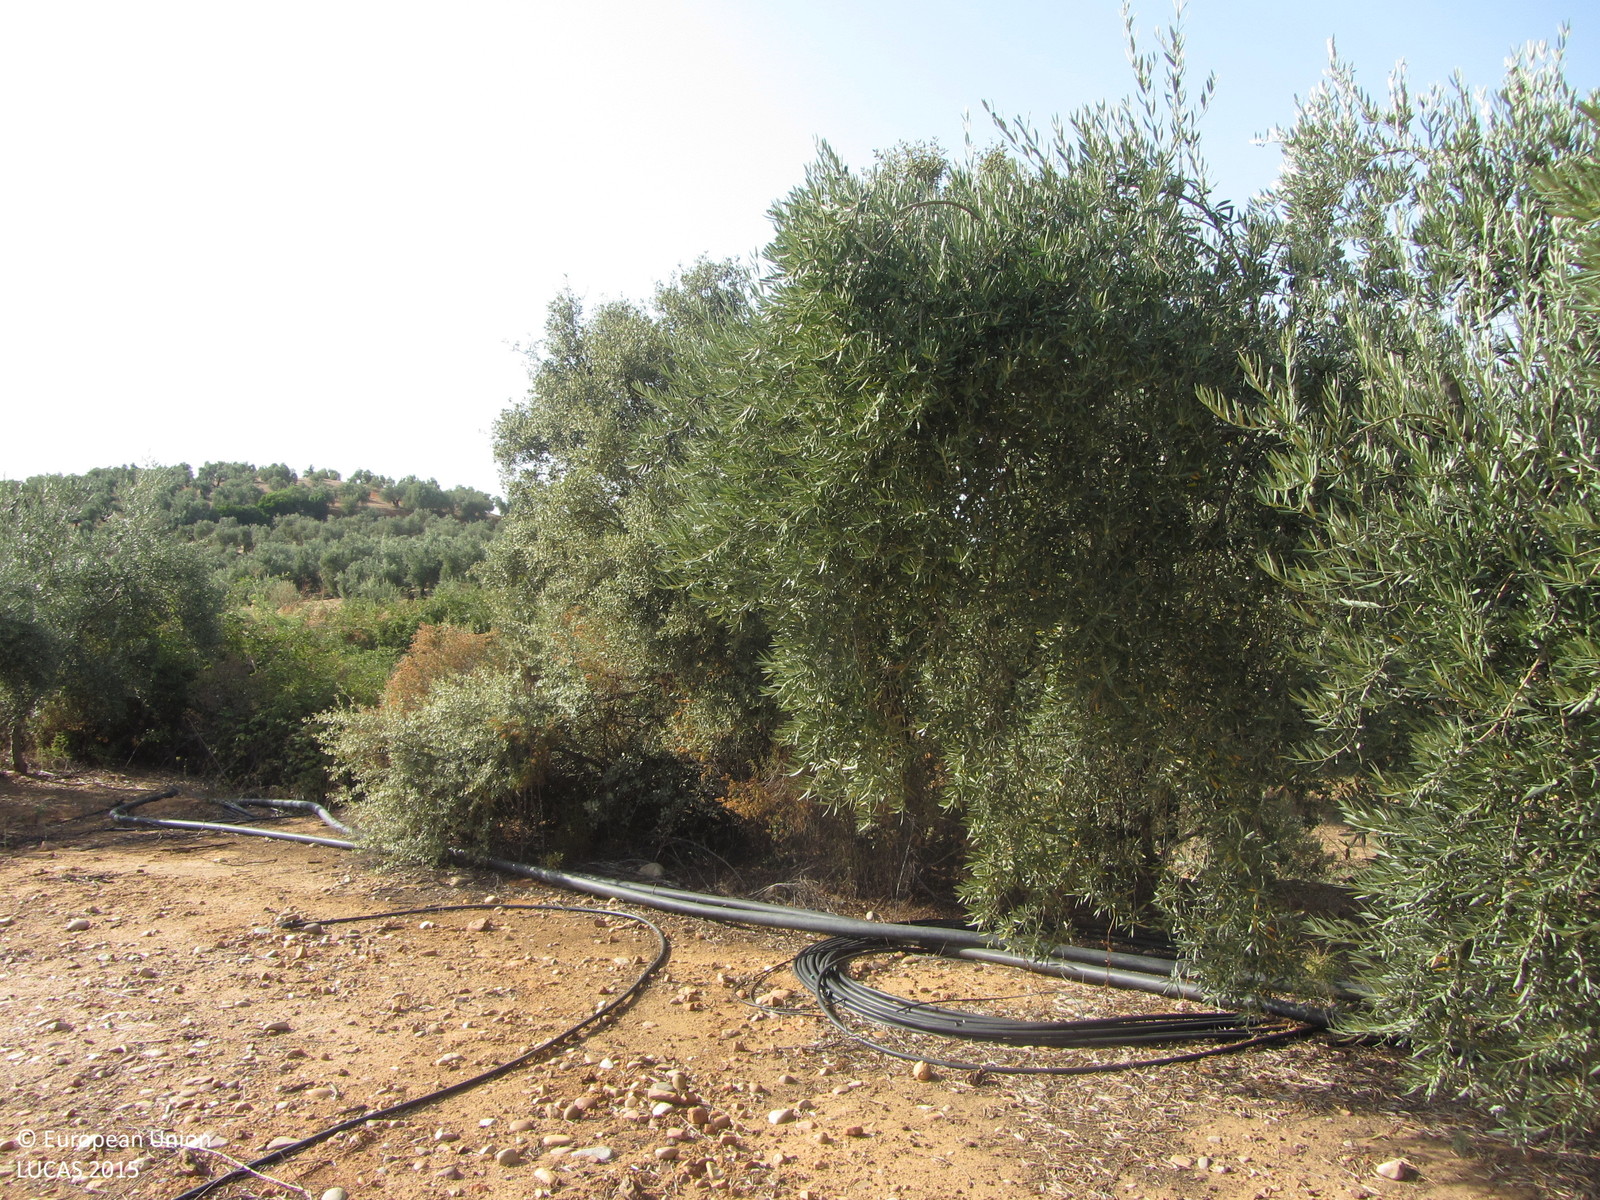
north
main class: Cropland
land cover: Olive groves
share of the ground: 10 - 25 %
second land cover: Other bare soil
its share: > 75 %
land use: Agriculture (excluding fallow land and kitchen gardens)
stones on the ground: < 10 %
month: July
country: ES
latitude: 38.0797
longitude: -3.9037
